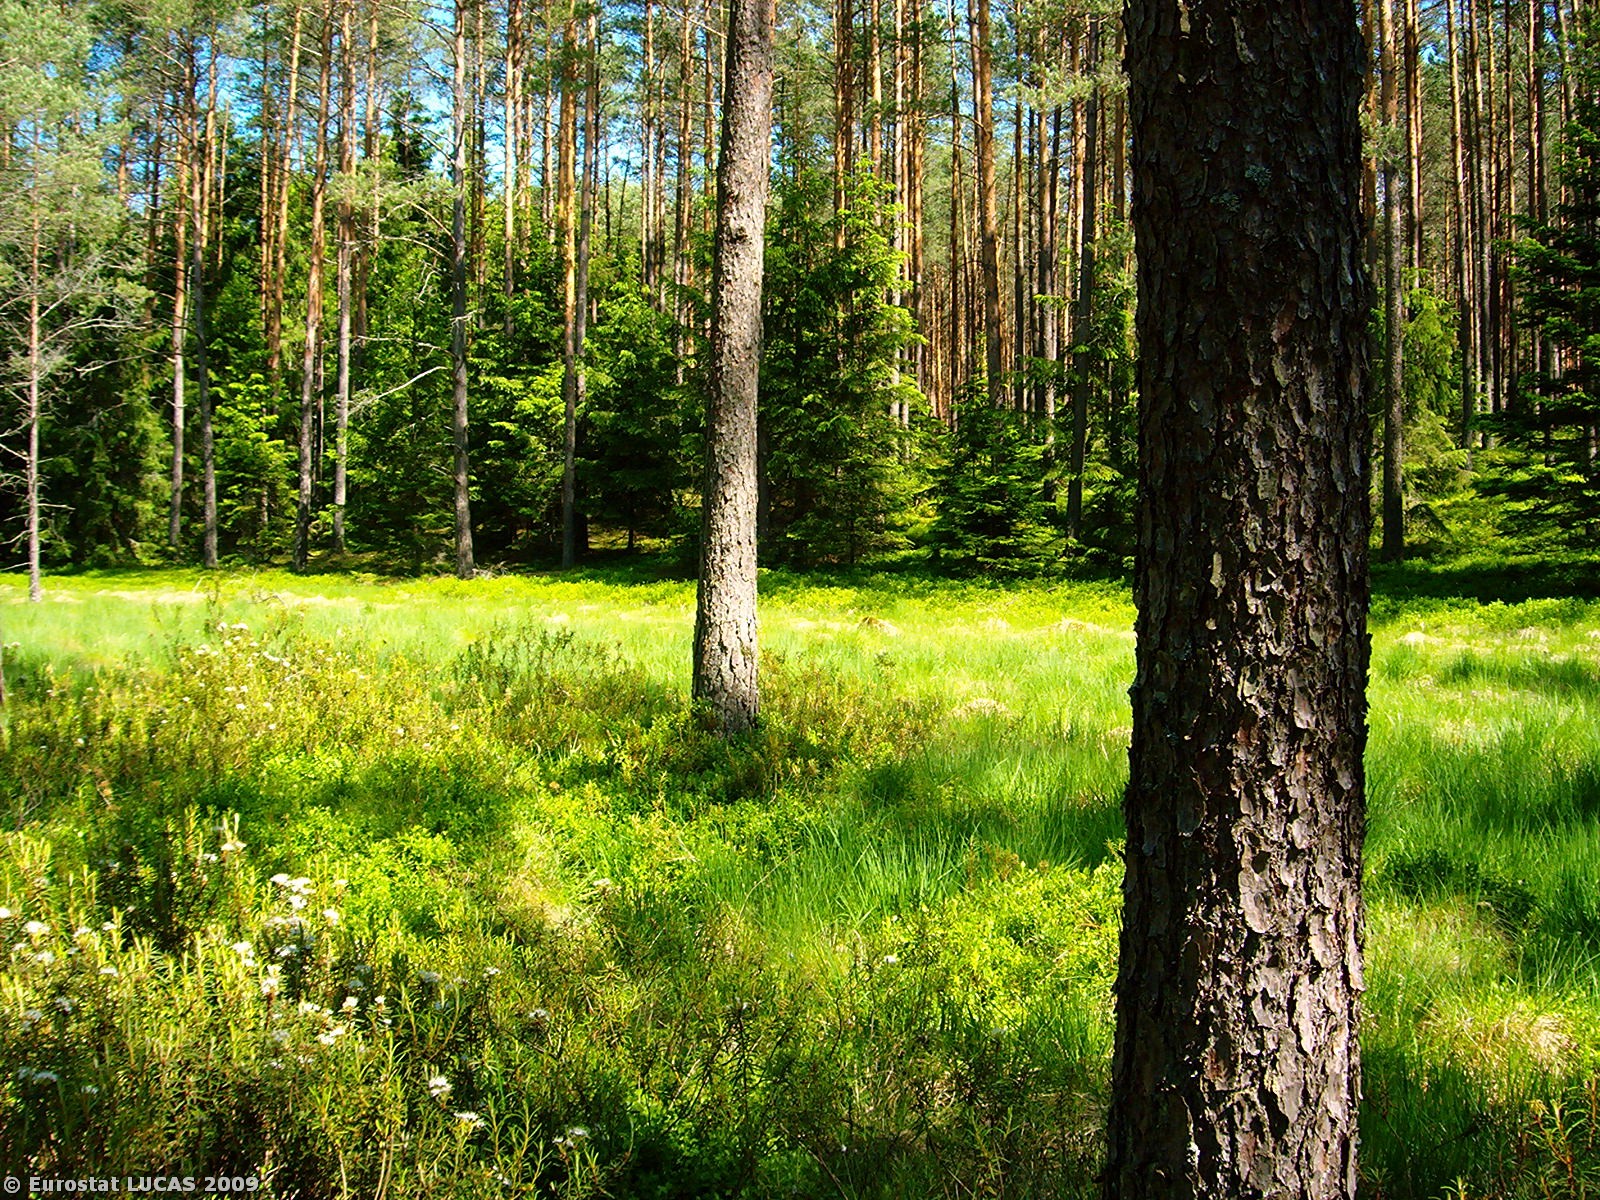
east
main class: Woodland
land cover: Coniferous woodland
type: hemiboreal forest and nemoral coniferous forest and mixed broadleaved-coniferous forest
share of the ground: 50 - 75 %
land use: Forestry
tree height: > 5 m
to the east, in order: Coniferous woodland
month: June
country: PL
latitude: 53.9089
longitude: 17.2099
